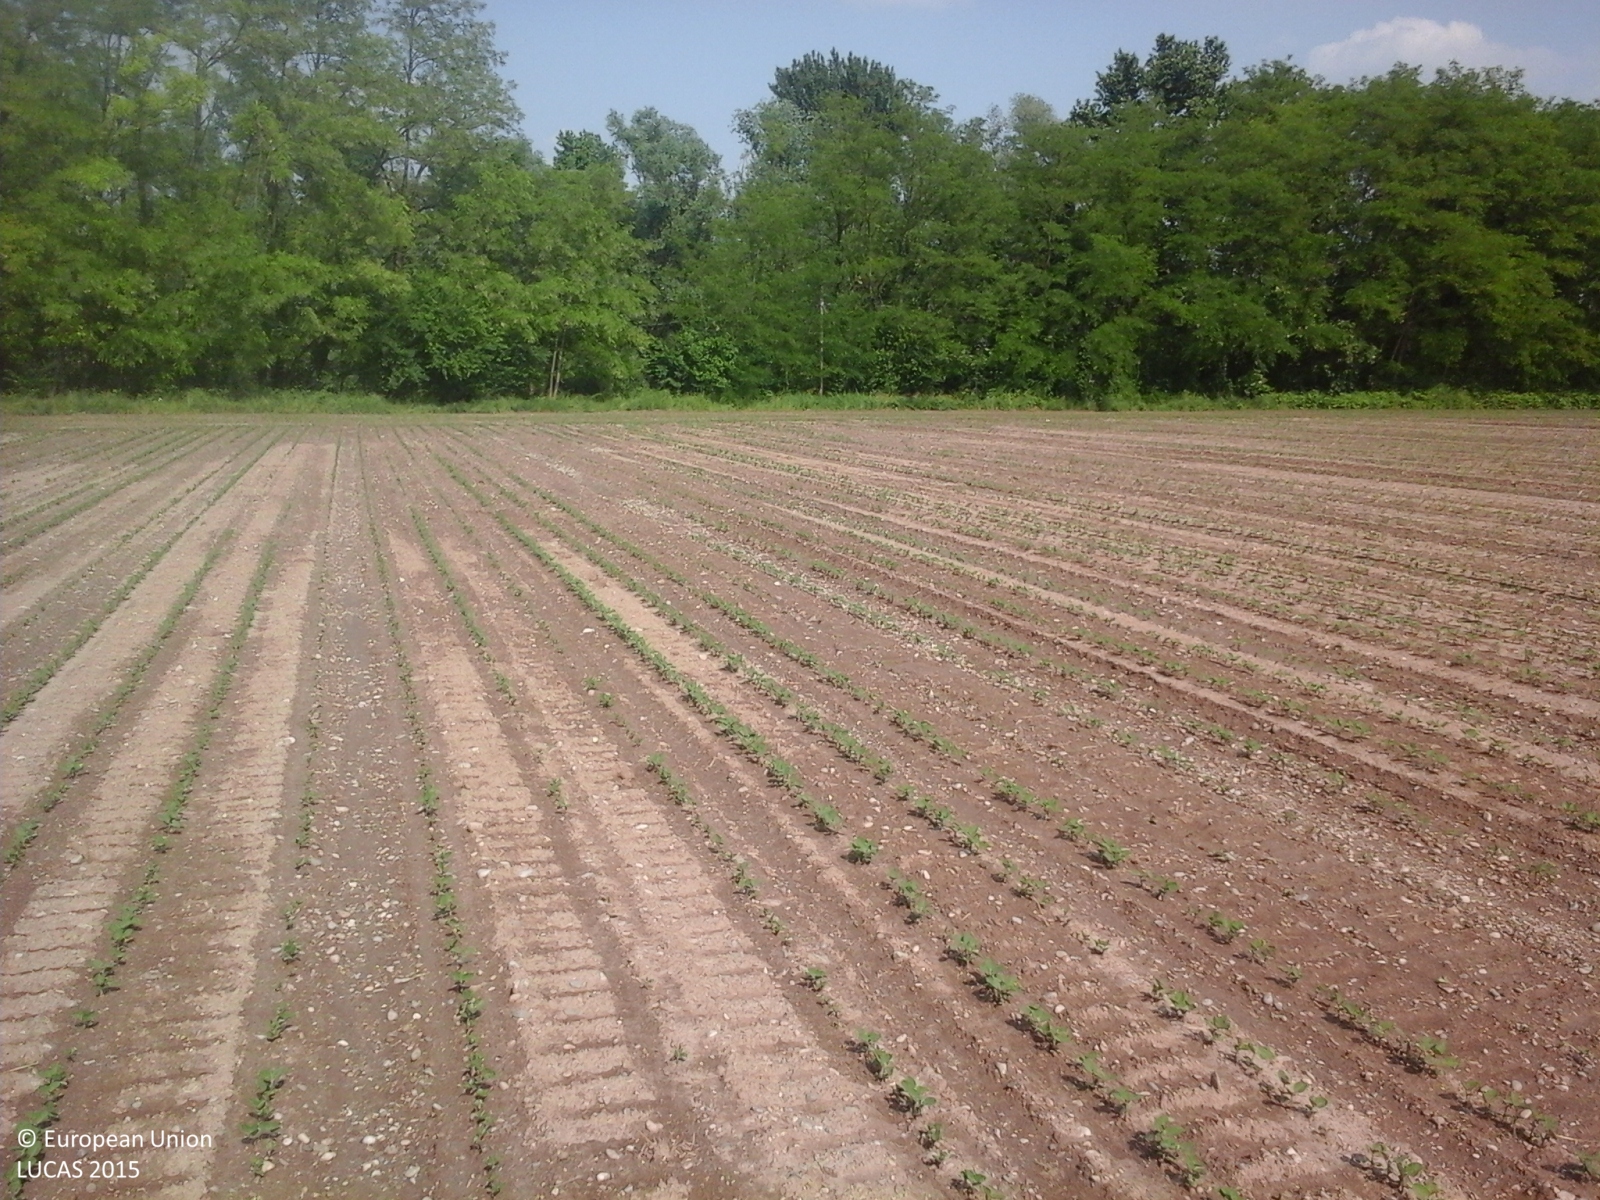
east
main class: Cropland
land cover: Soya
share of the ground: < 10 %
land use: Agriculture (excluding fallow land and kitchen gardens)
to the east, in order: Soya; Broadleaved woodland; Electric lines; Inland fresh running water; Broadleaved woodland; Tracks; Grass margins; Soya; Managed hedges; Ditches and canals; Managed hedges; Maize
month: May
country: IT
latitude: 45.2874
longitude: 10.3945
